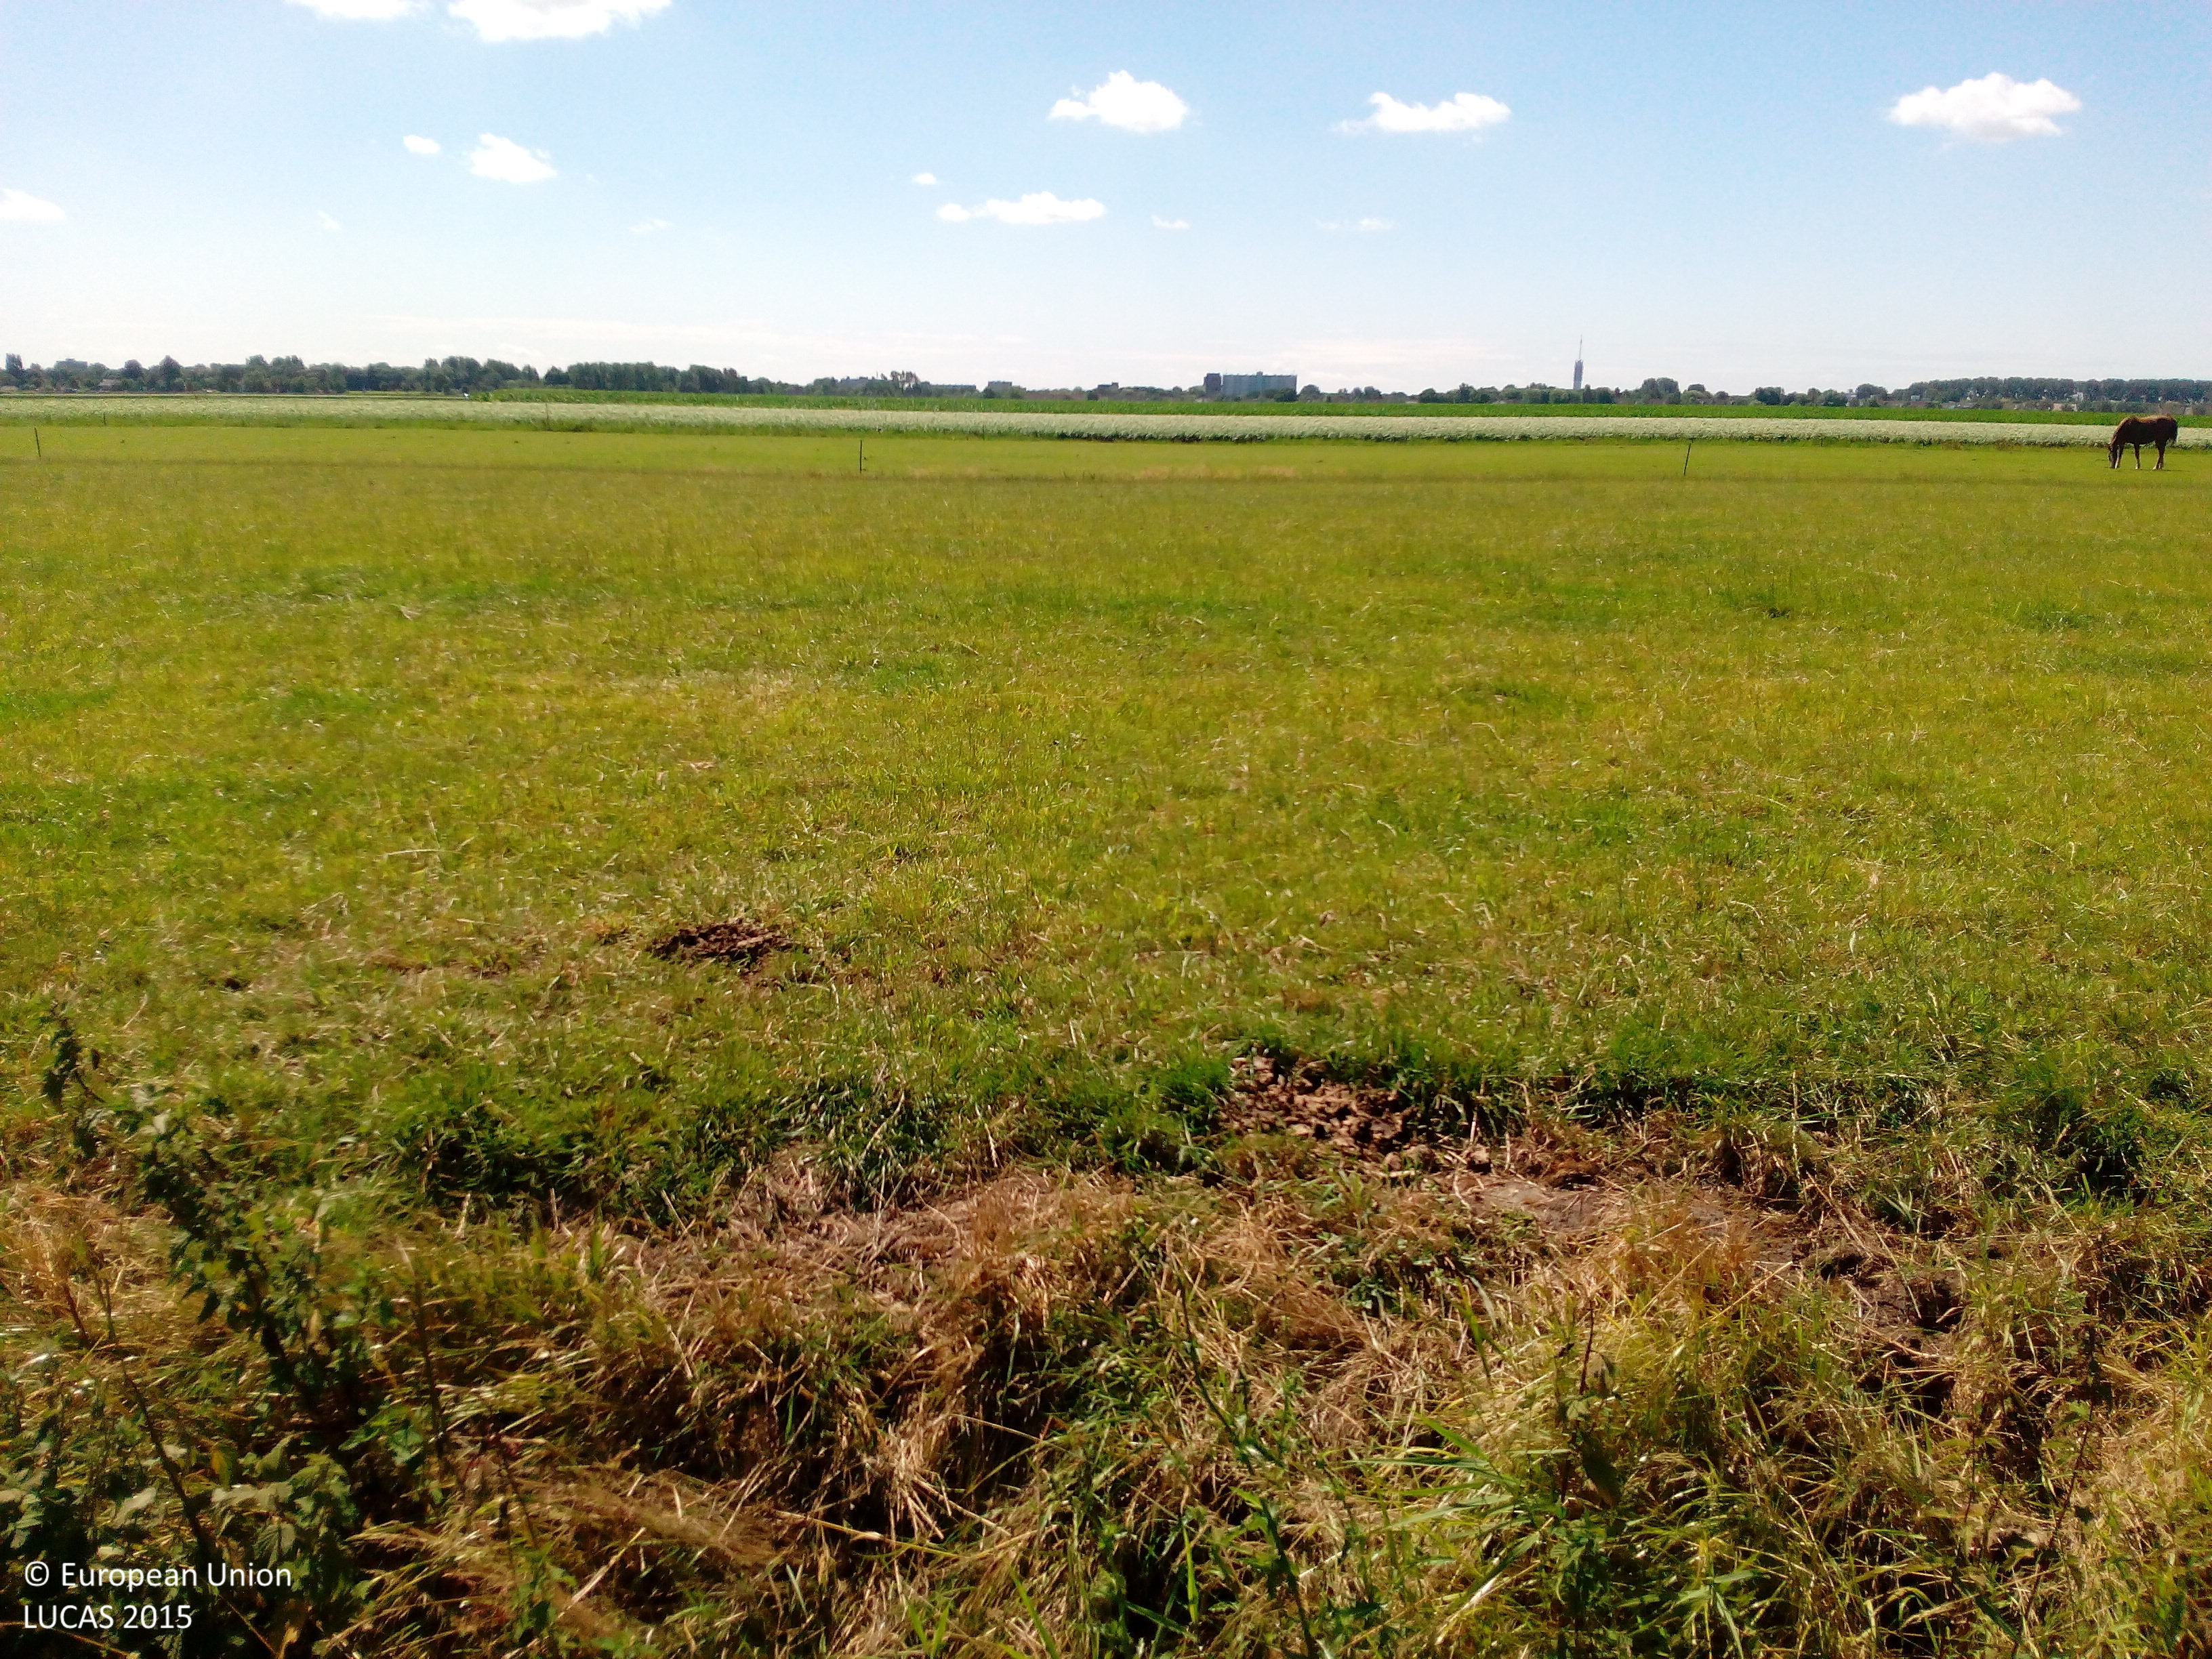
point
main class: Grassland
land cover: Grassland without tree/shrub cover
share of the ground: > 75 %
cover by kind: herbaceous plants 100 %
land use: Agriculture (excluding fallow land and kitchen gardens)
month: July
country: NL
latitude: 52.1673
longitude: 4.6599
